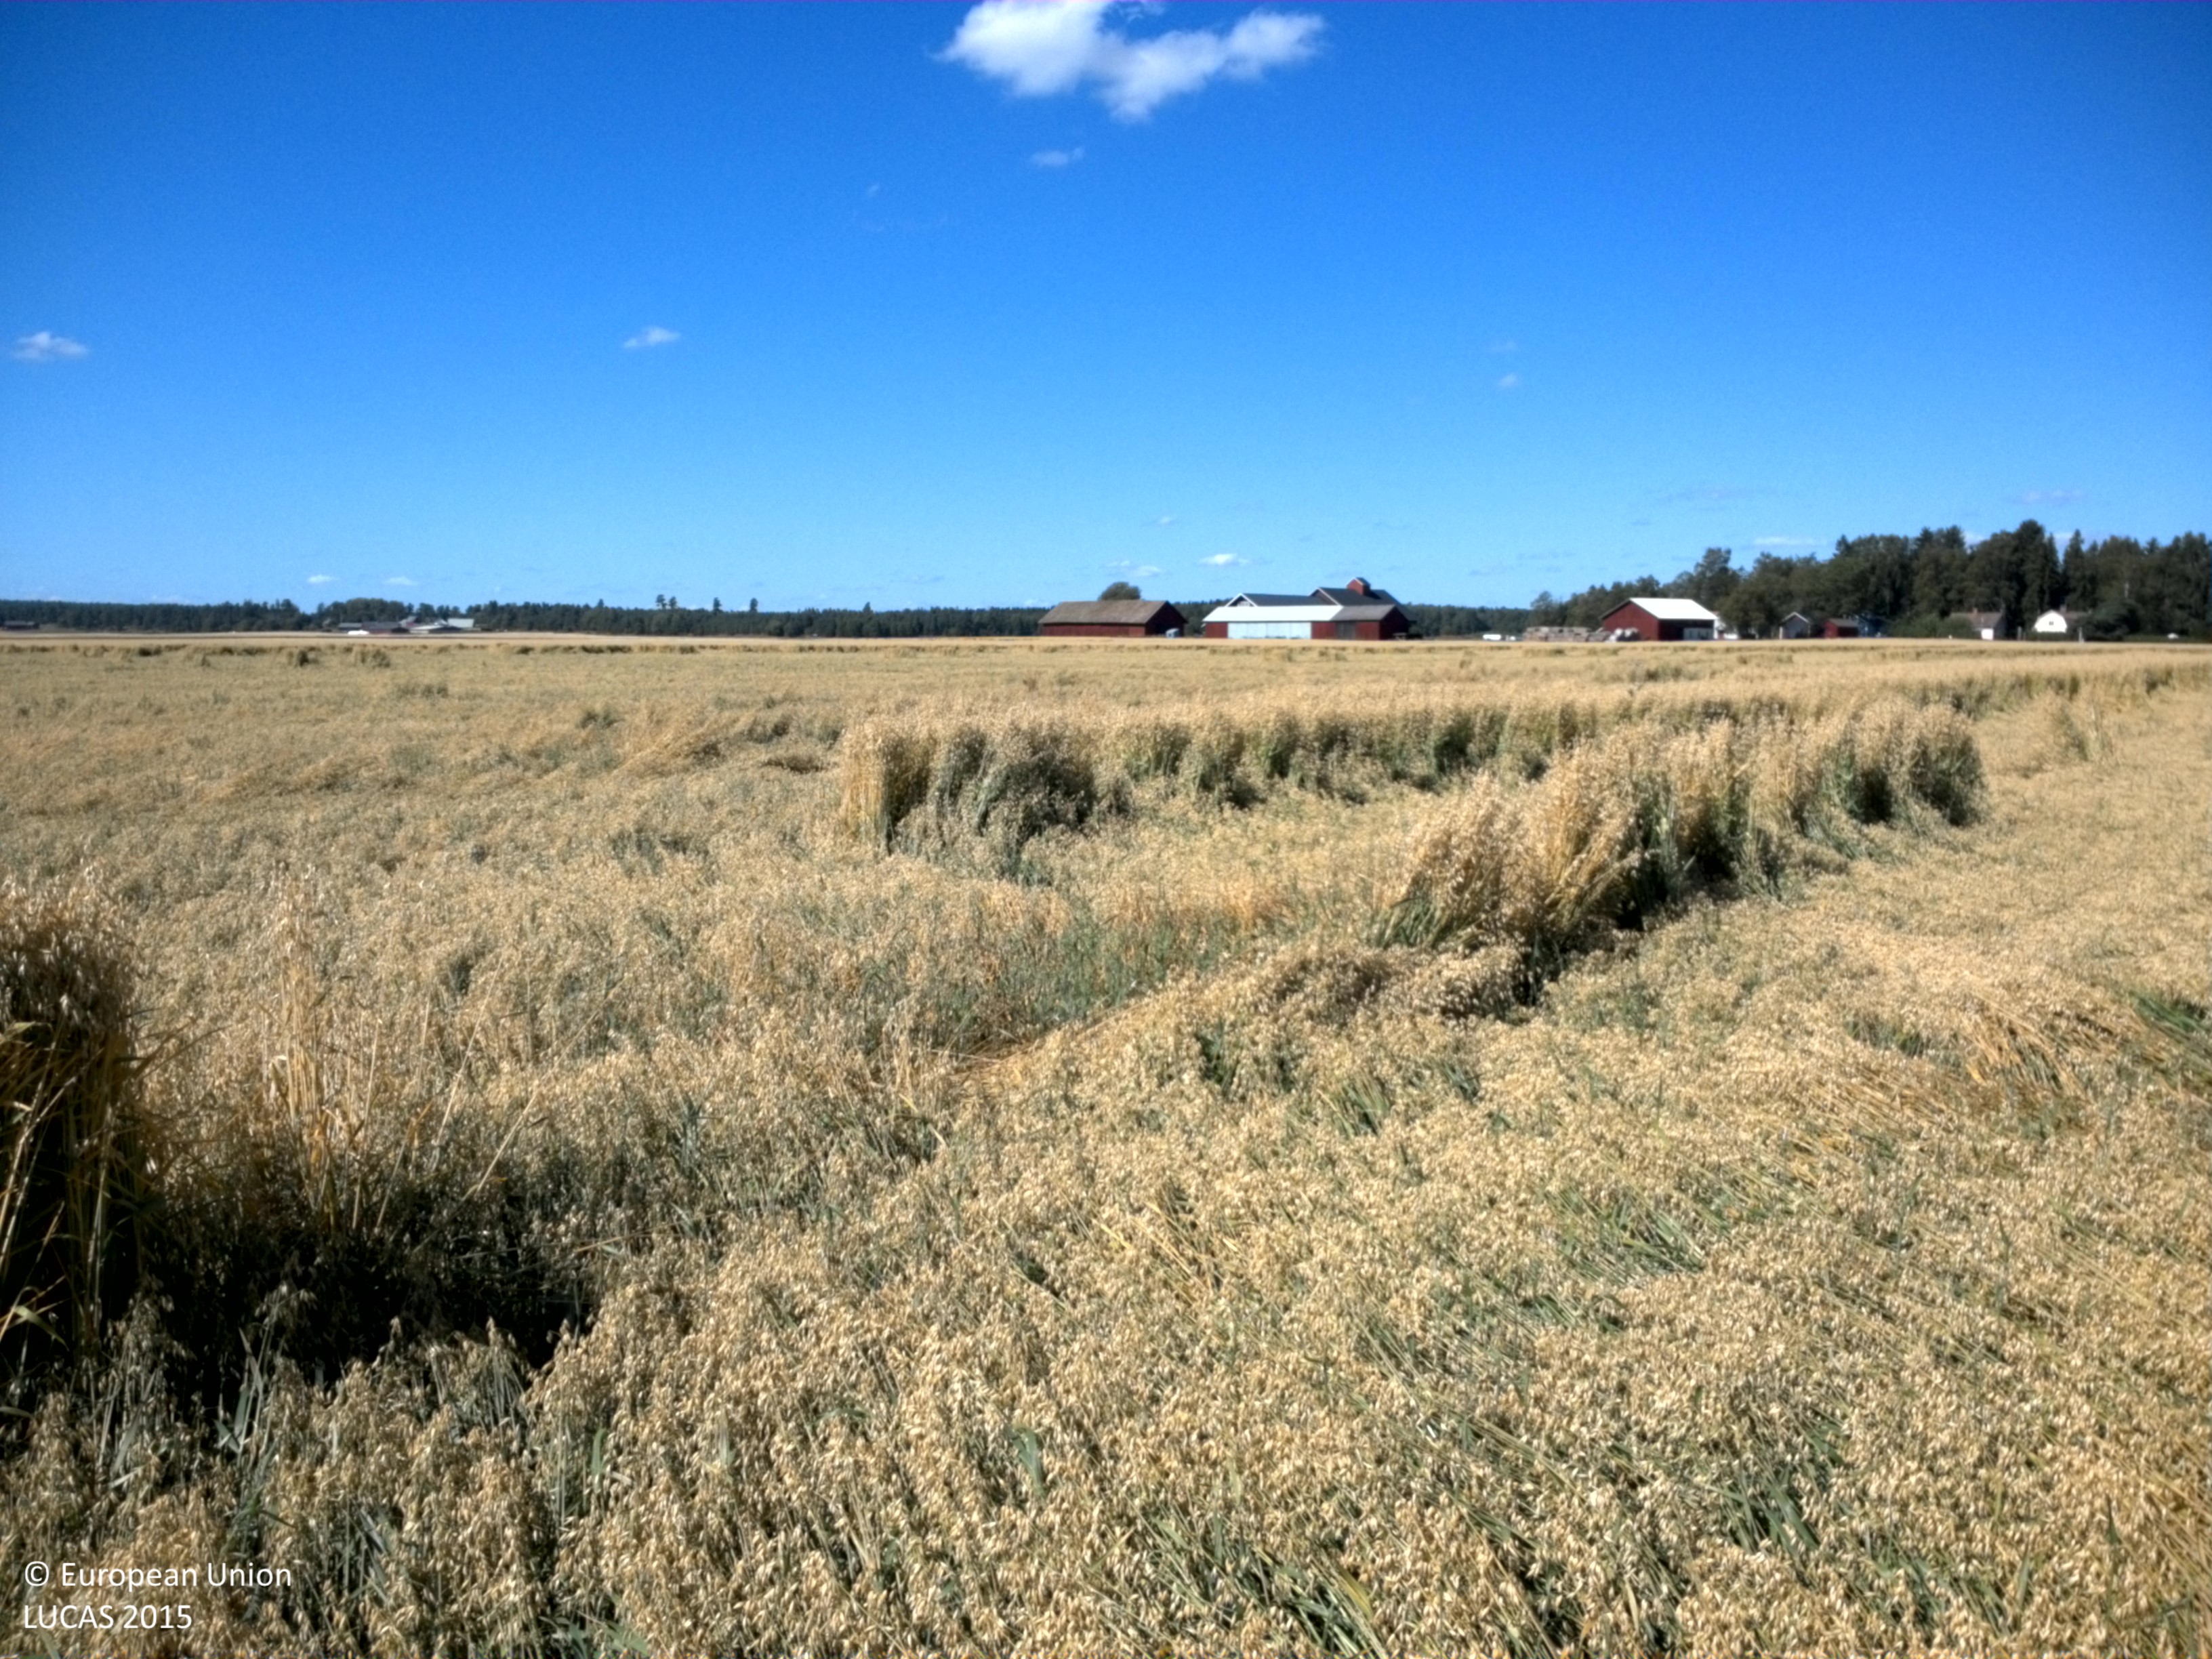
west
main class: Cropland
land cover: Oats
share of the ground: > 75 %
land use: Agriculture (excluding fallow land and kitchen gardens)
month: August
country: SE
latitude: 59.7716
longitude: 16.6340
